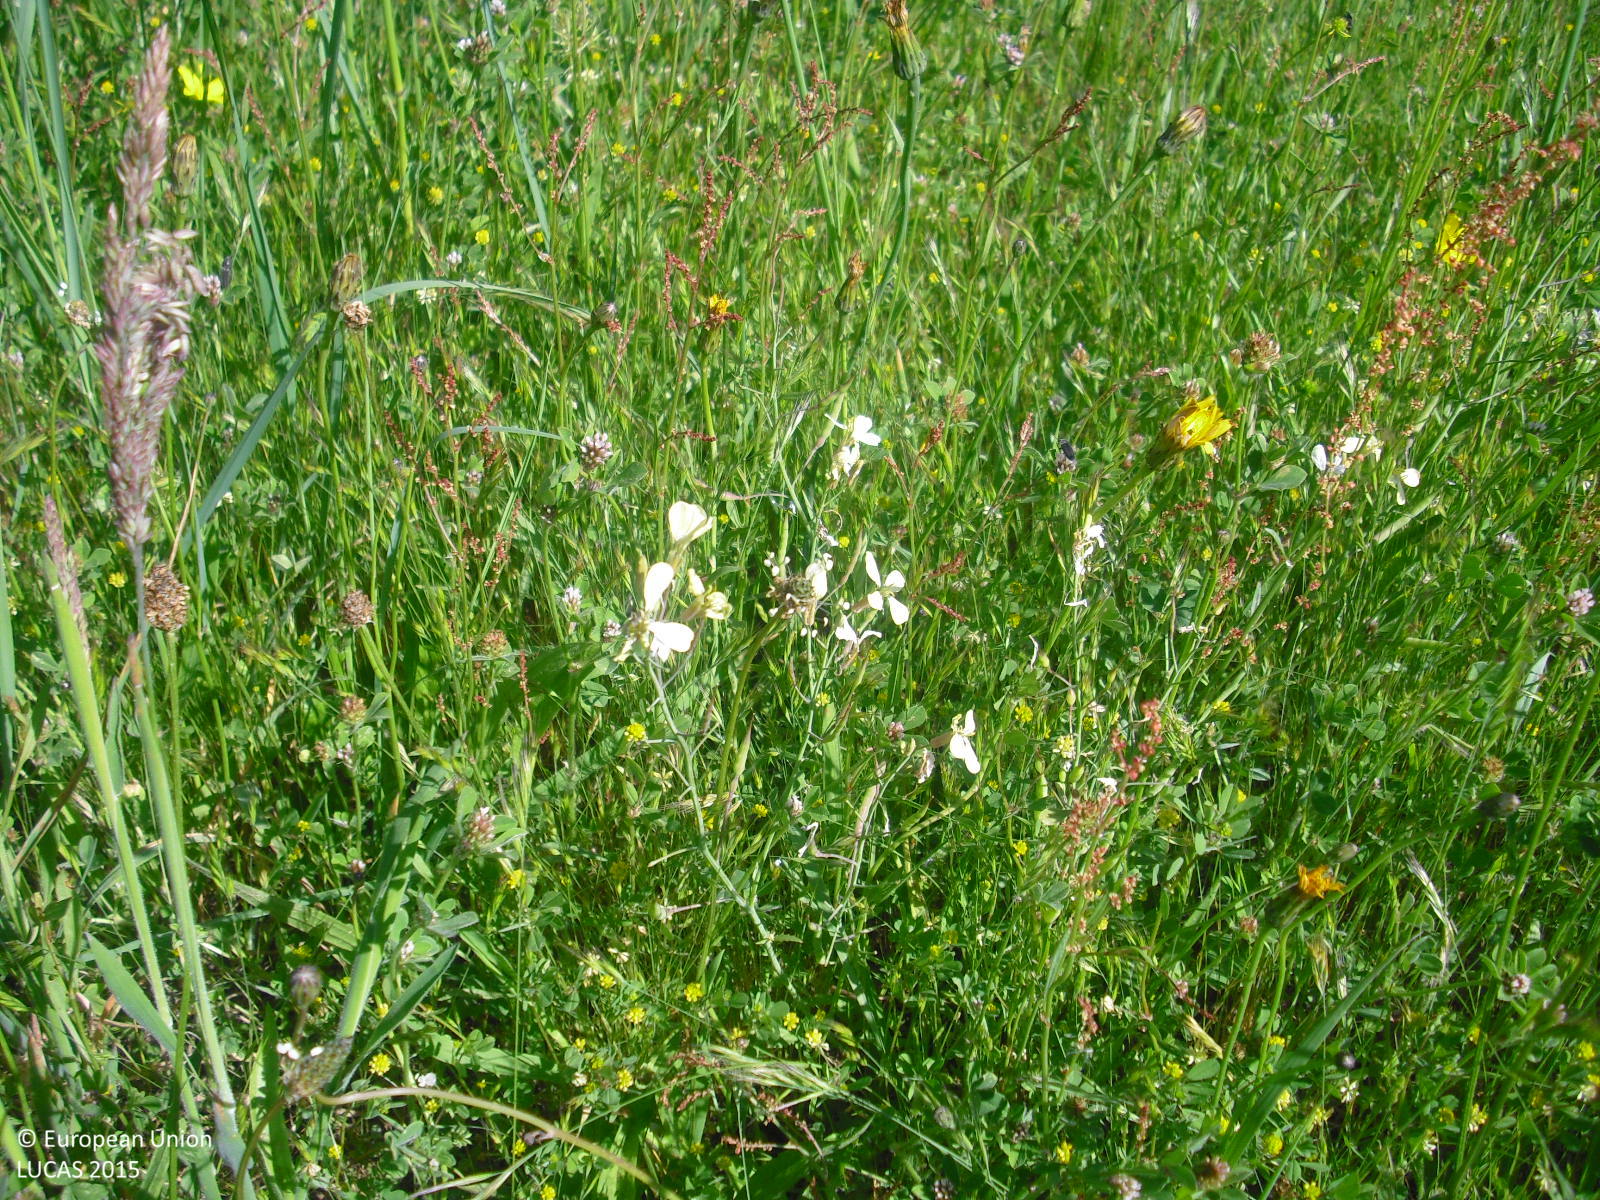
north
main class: Grassland
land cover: Grassland without tree/shrub cover
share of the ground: > 75 %
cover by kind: herbaceous plants 100 %
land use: Agriculture (excluding fallow land and kitchen gardens)
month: May
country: ES
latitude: 41.9596
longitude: -8.1413
